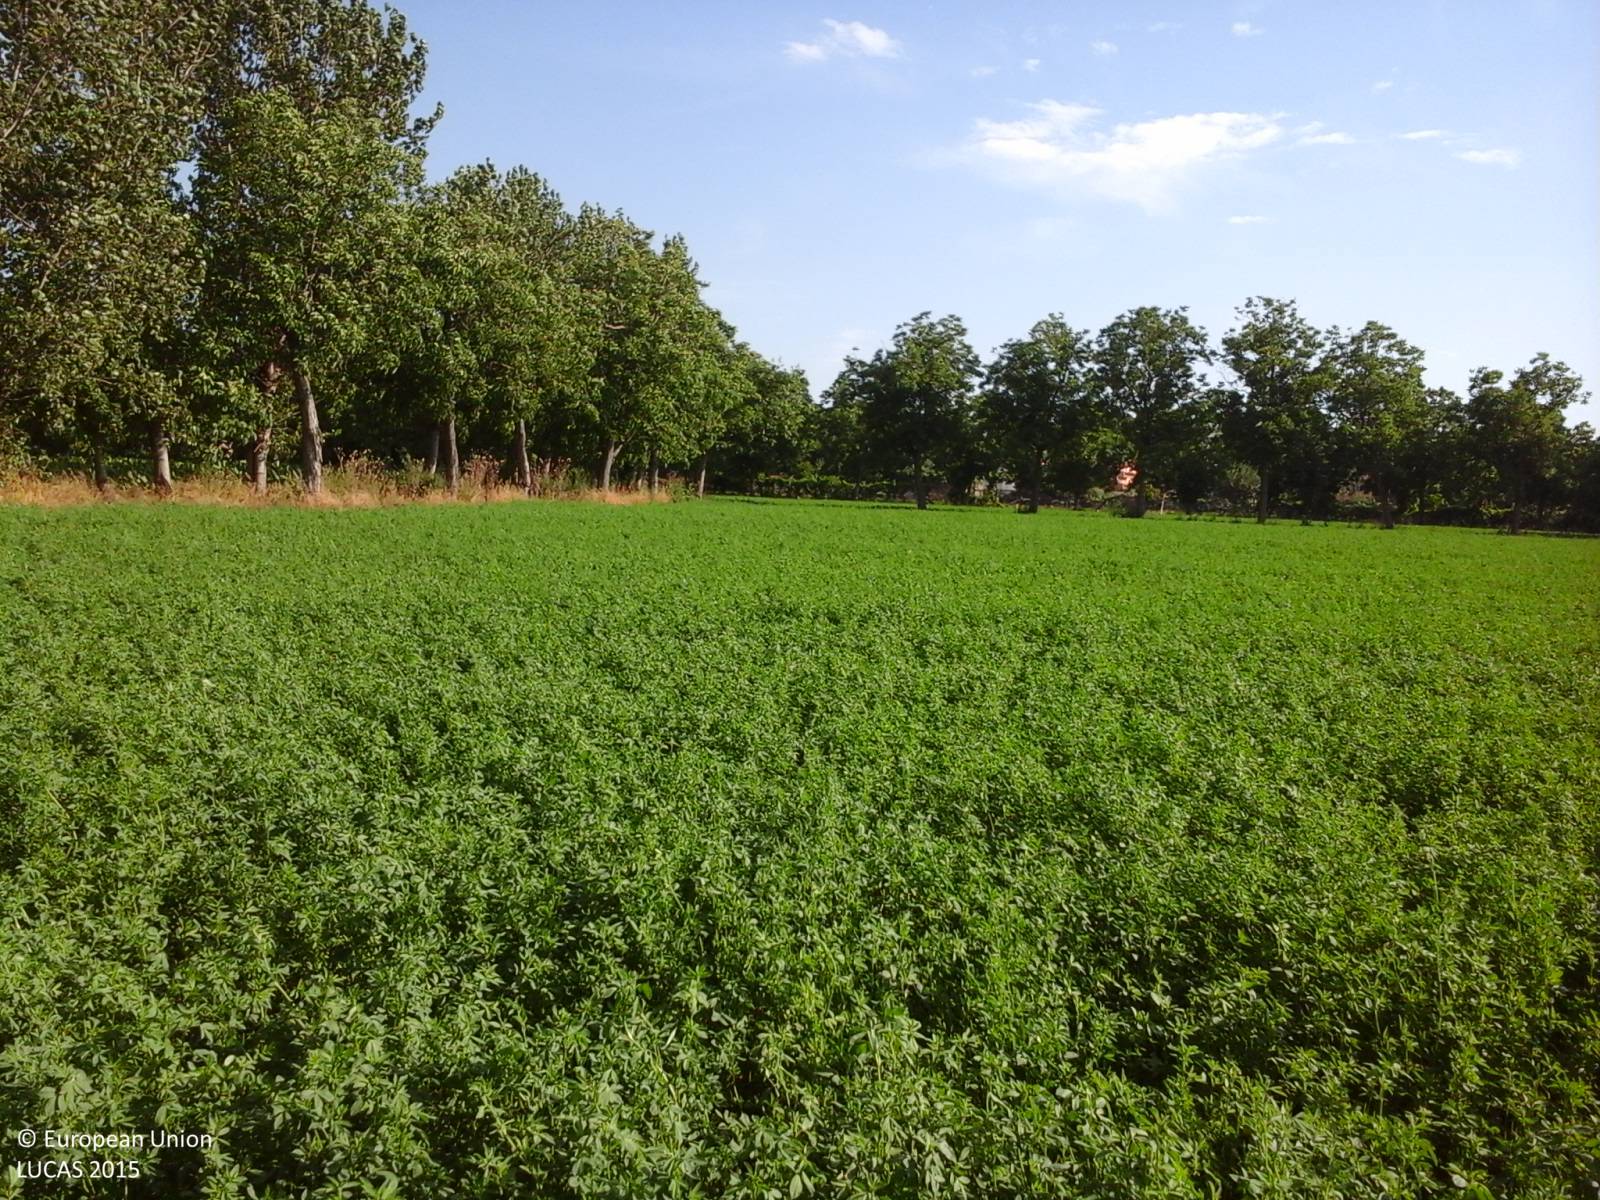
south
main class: Cropland
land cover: Lucerne
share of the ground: > 75 %
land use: Agriculture (excluding fallow land and kitchen gardens)
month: June
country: IT
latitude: 40.9895
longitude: 14.2737
